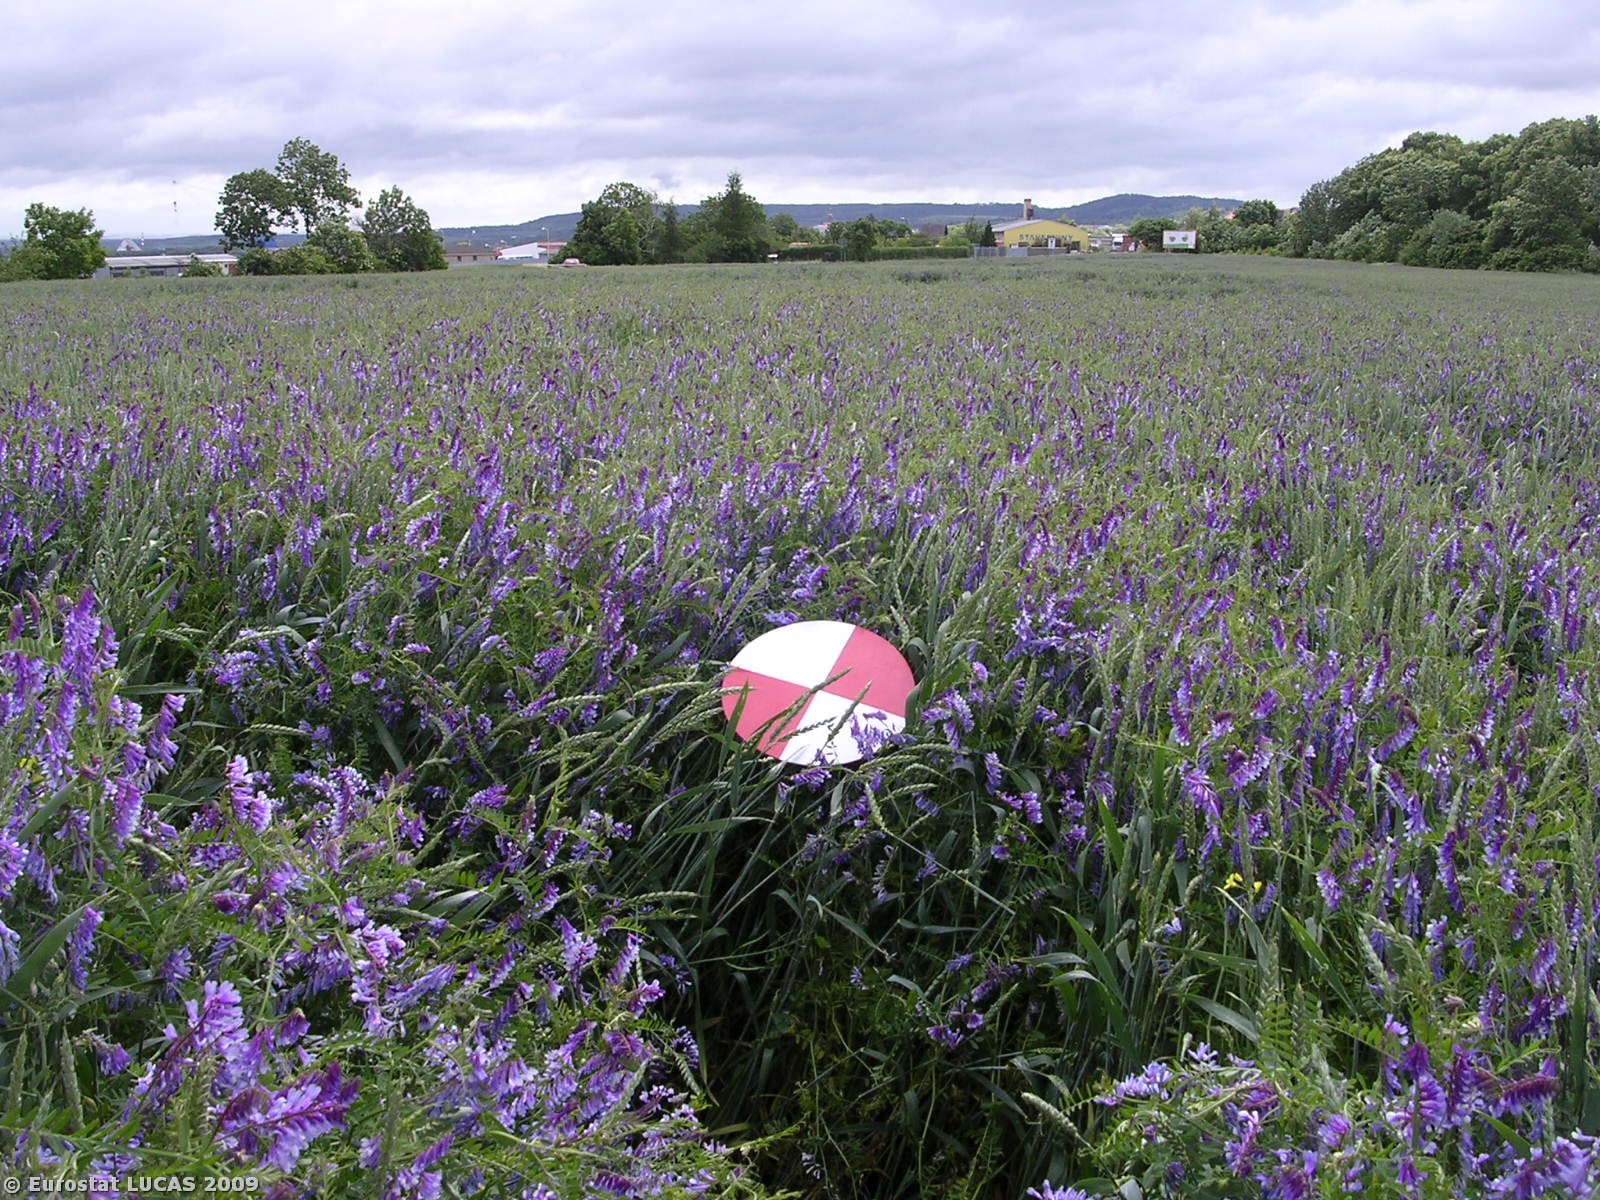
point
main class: Cropland
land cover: Common wheat
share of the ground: 50 - 75 %
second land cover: Dry pulses
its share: 25 - 50 %
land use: Agriculture (excluding fallow land and kitchen gardens)
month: May
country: CZ
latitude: 50.4296
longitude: 14.2386
